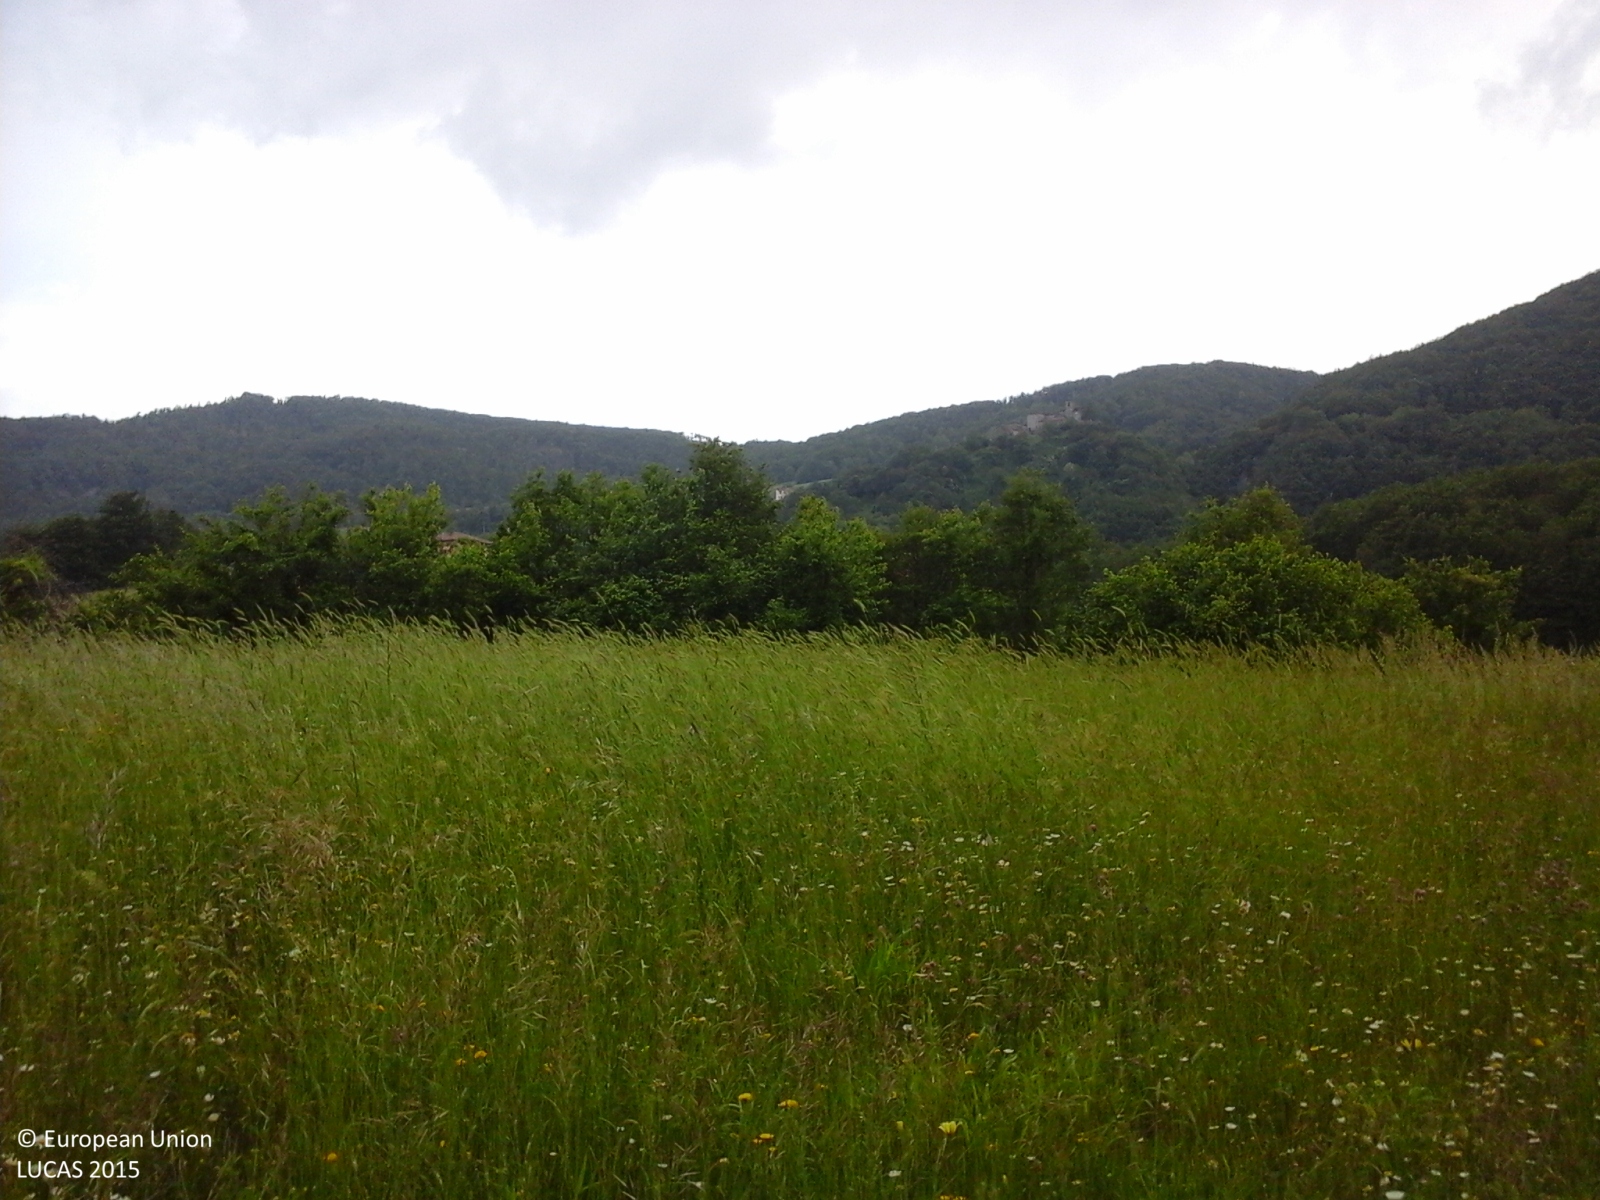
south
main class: Woodland
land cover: Broadleaved woodland
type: thermophilous deciduous forest
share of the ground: > 75 %
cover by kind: broadleaved forest trees 70 %, shrubs 30 %
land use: Forestry
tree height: > 5 m
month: May
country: IT
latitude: 44.6571
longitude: 9.9119
